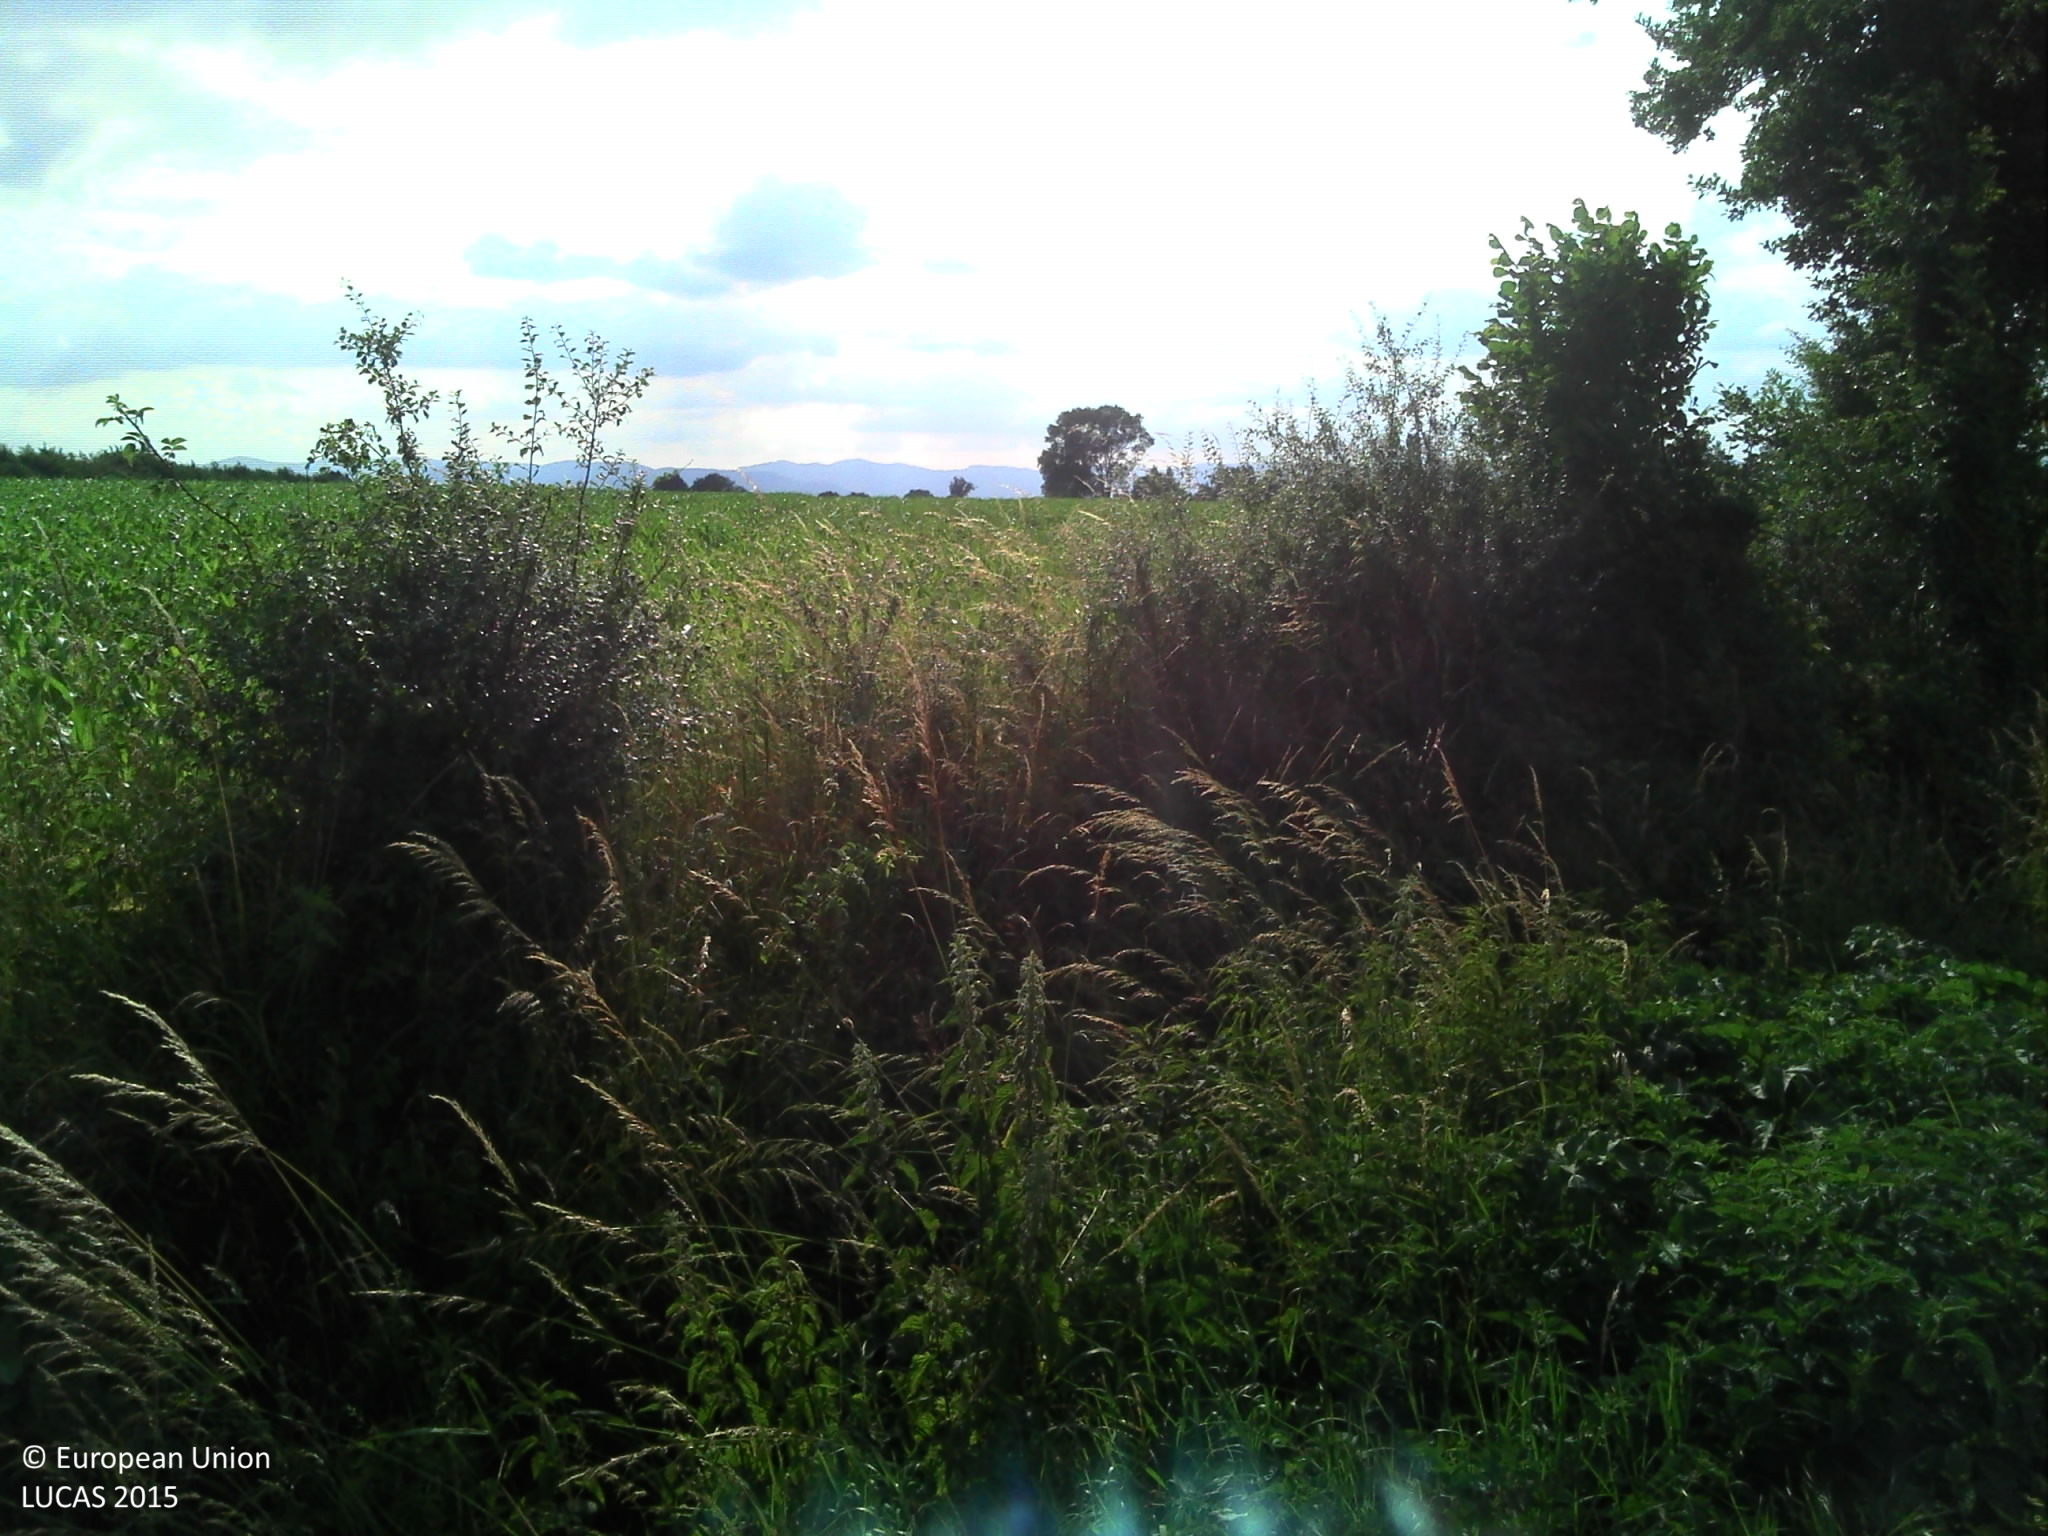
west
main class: Cropland
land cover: Maize
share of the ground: 25 - 50 %
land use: Agriculture (excluding fallow land and kitchen gardens)
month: June
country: FR
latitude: 46.0453
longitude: 4.8208
